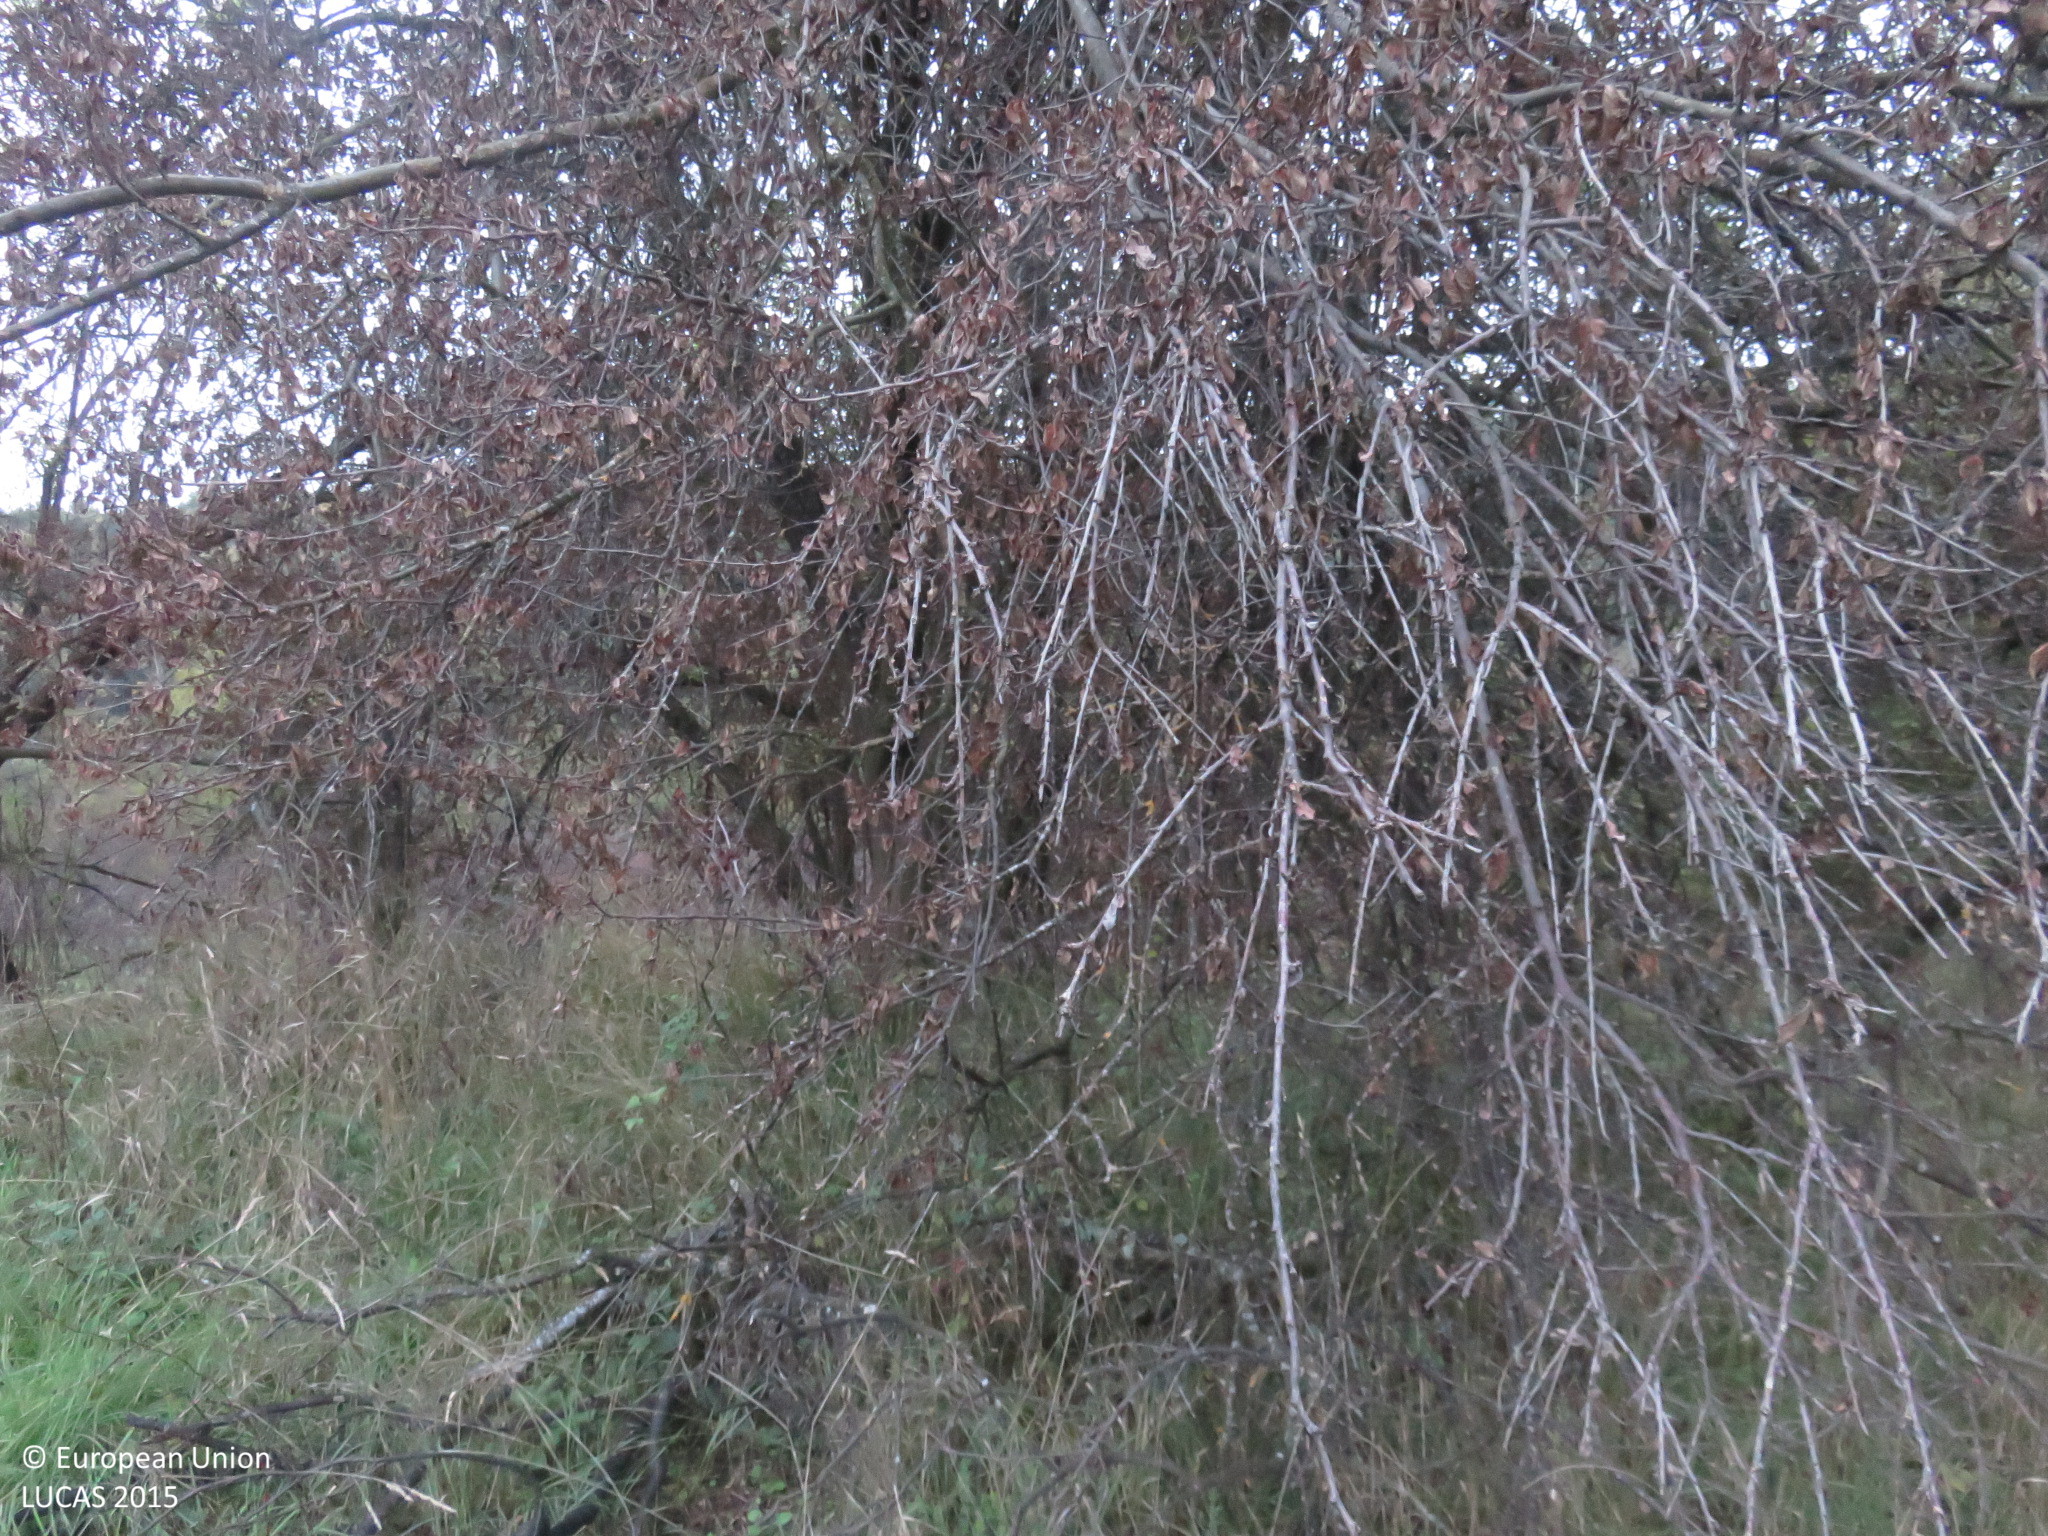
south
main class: Grassland
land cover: Grassland without tree/shrub cover
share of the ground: > 75 %
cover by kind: herbaceous plants 100 %
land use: Agriculture (excluding fallow land and kitchen gardens)
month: October
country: BG
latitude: 42.9539
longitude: 25.2826
